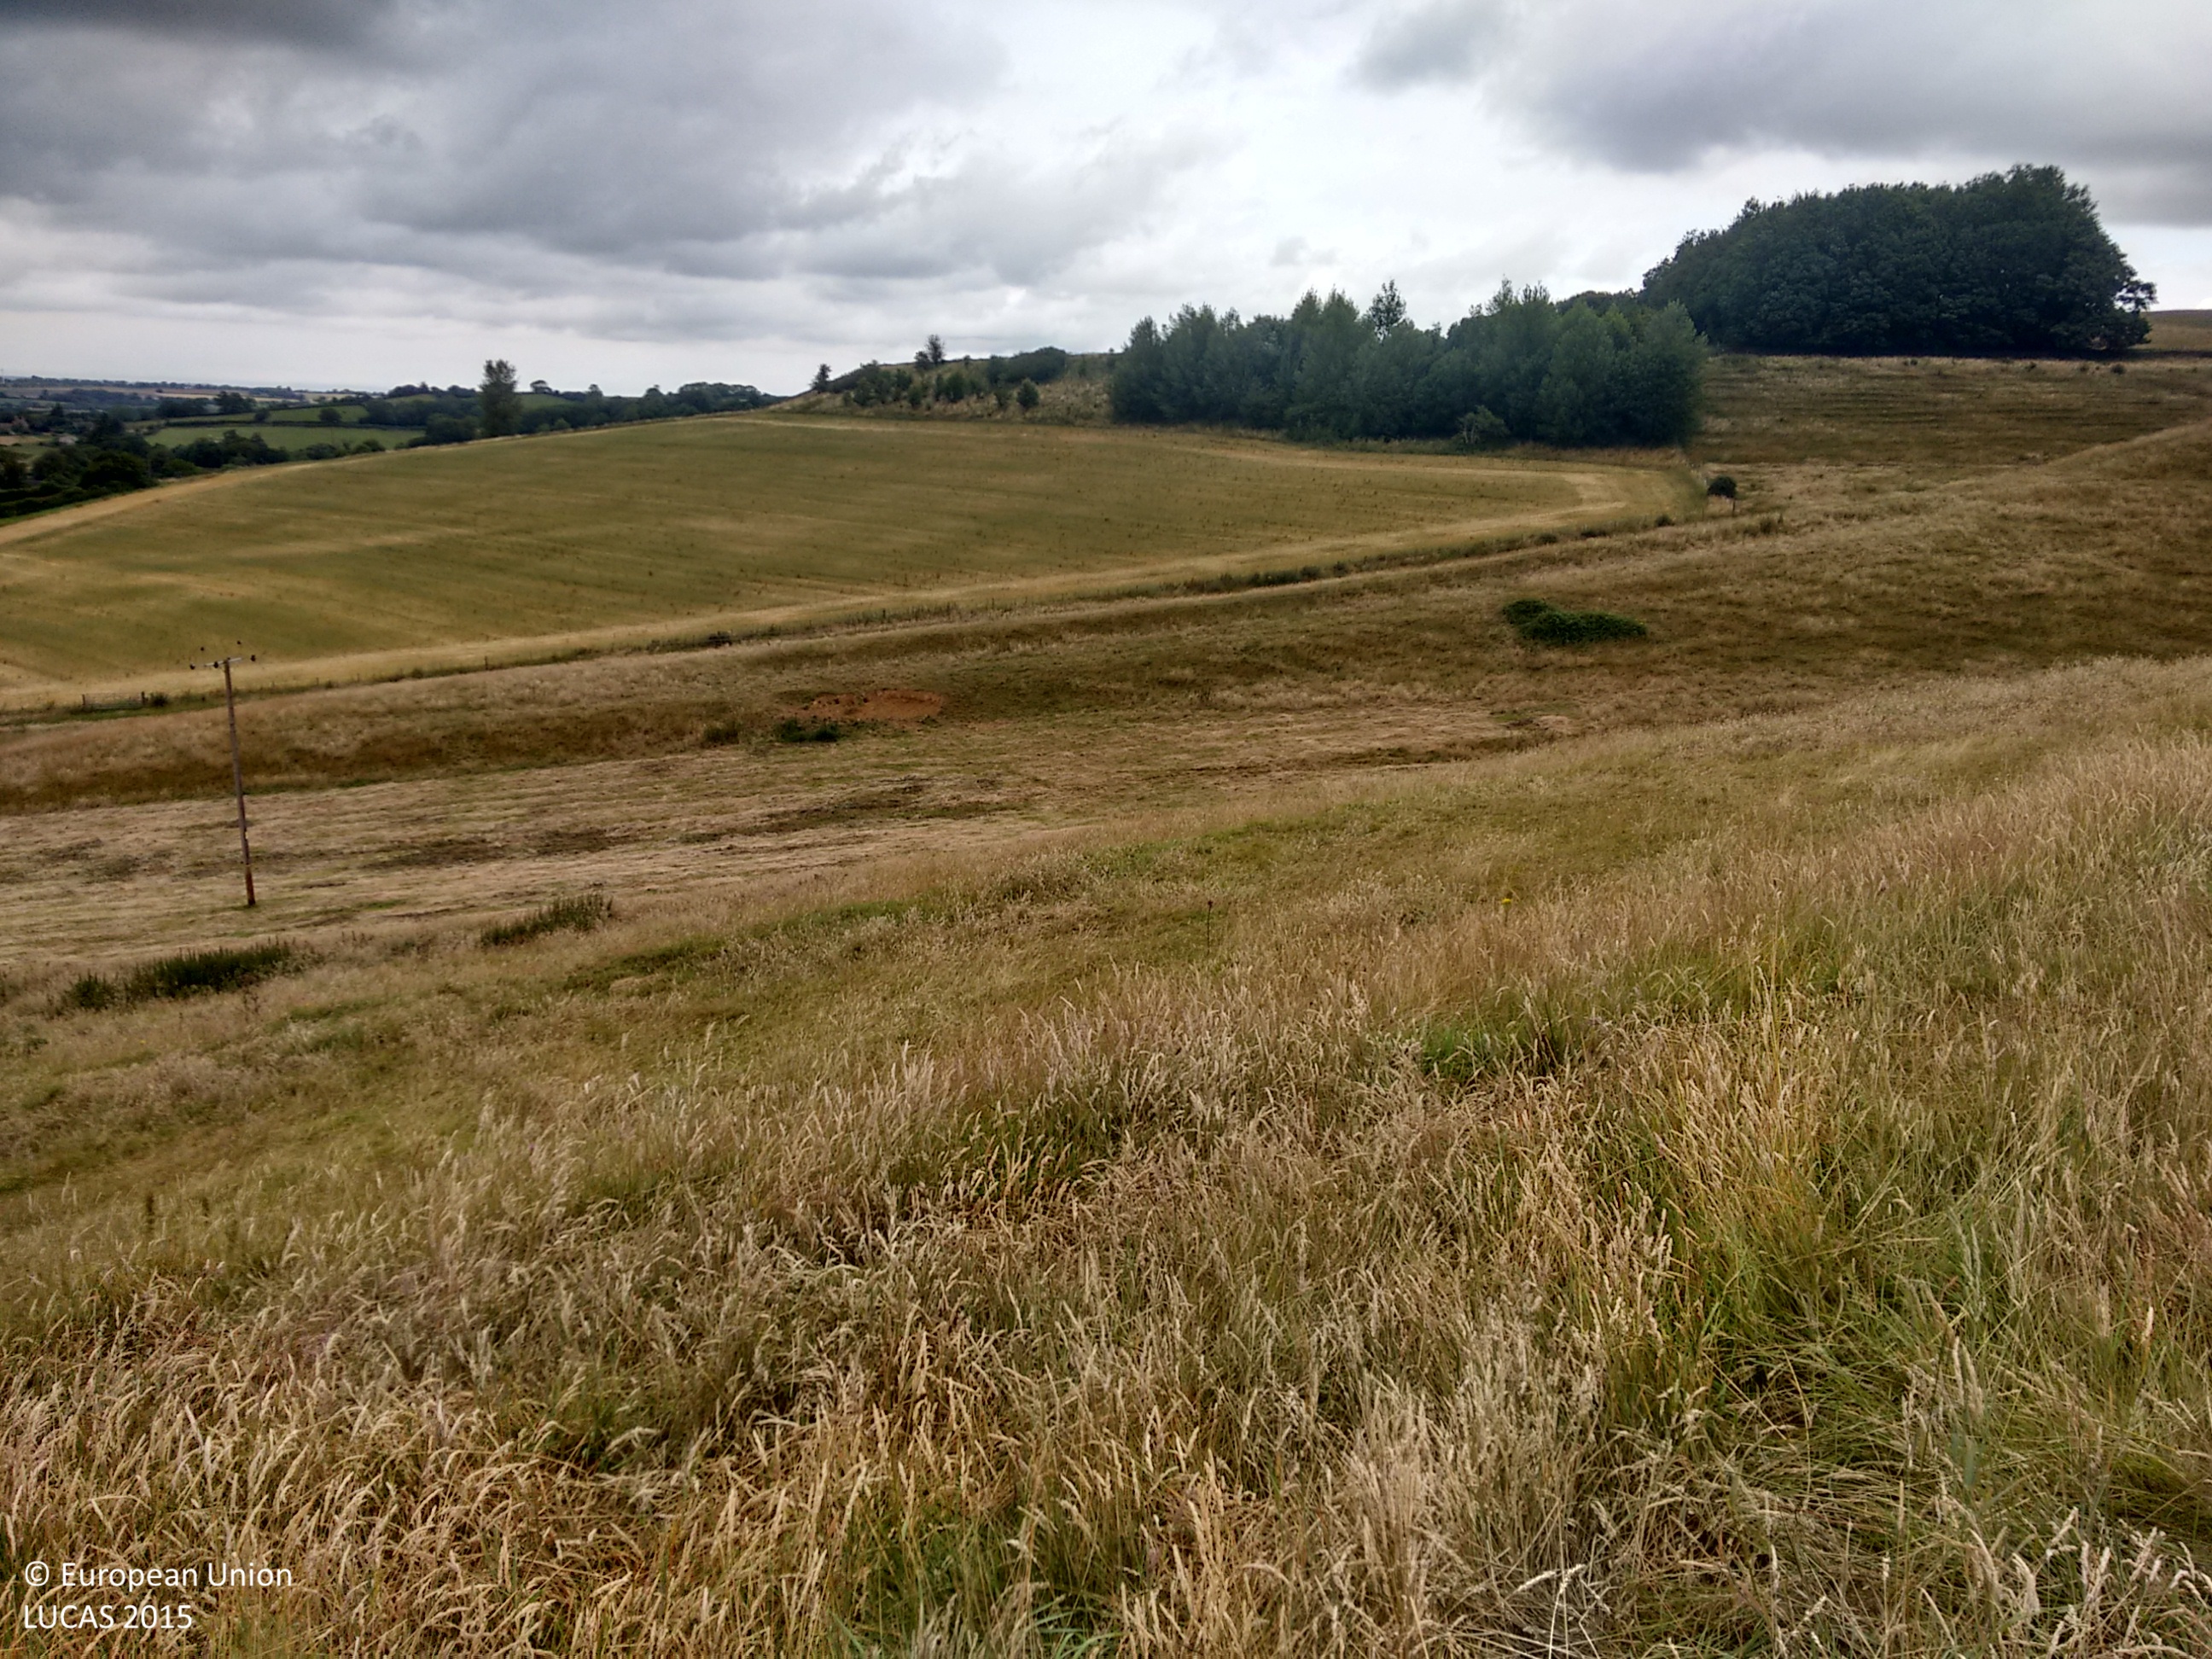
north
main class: Grassland
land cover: Grassland without tree/shrub cover
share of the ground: > 75 %
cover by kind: herbaceous plants 100 %
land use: Agriculture (excluding fallow land and kitchen gardens)
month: July
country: GB
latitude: 51.4723
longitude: -2.3736
